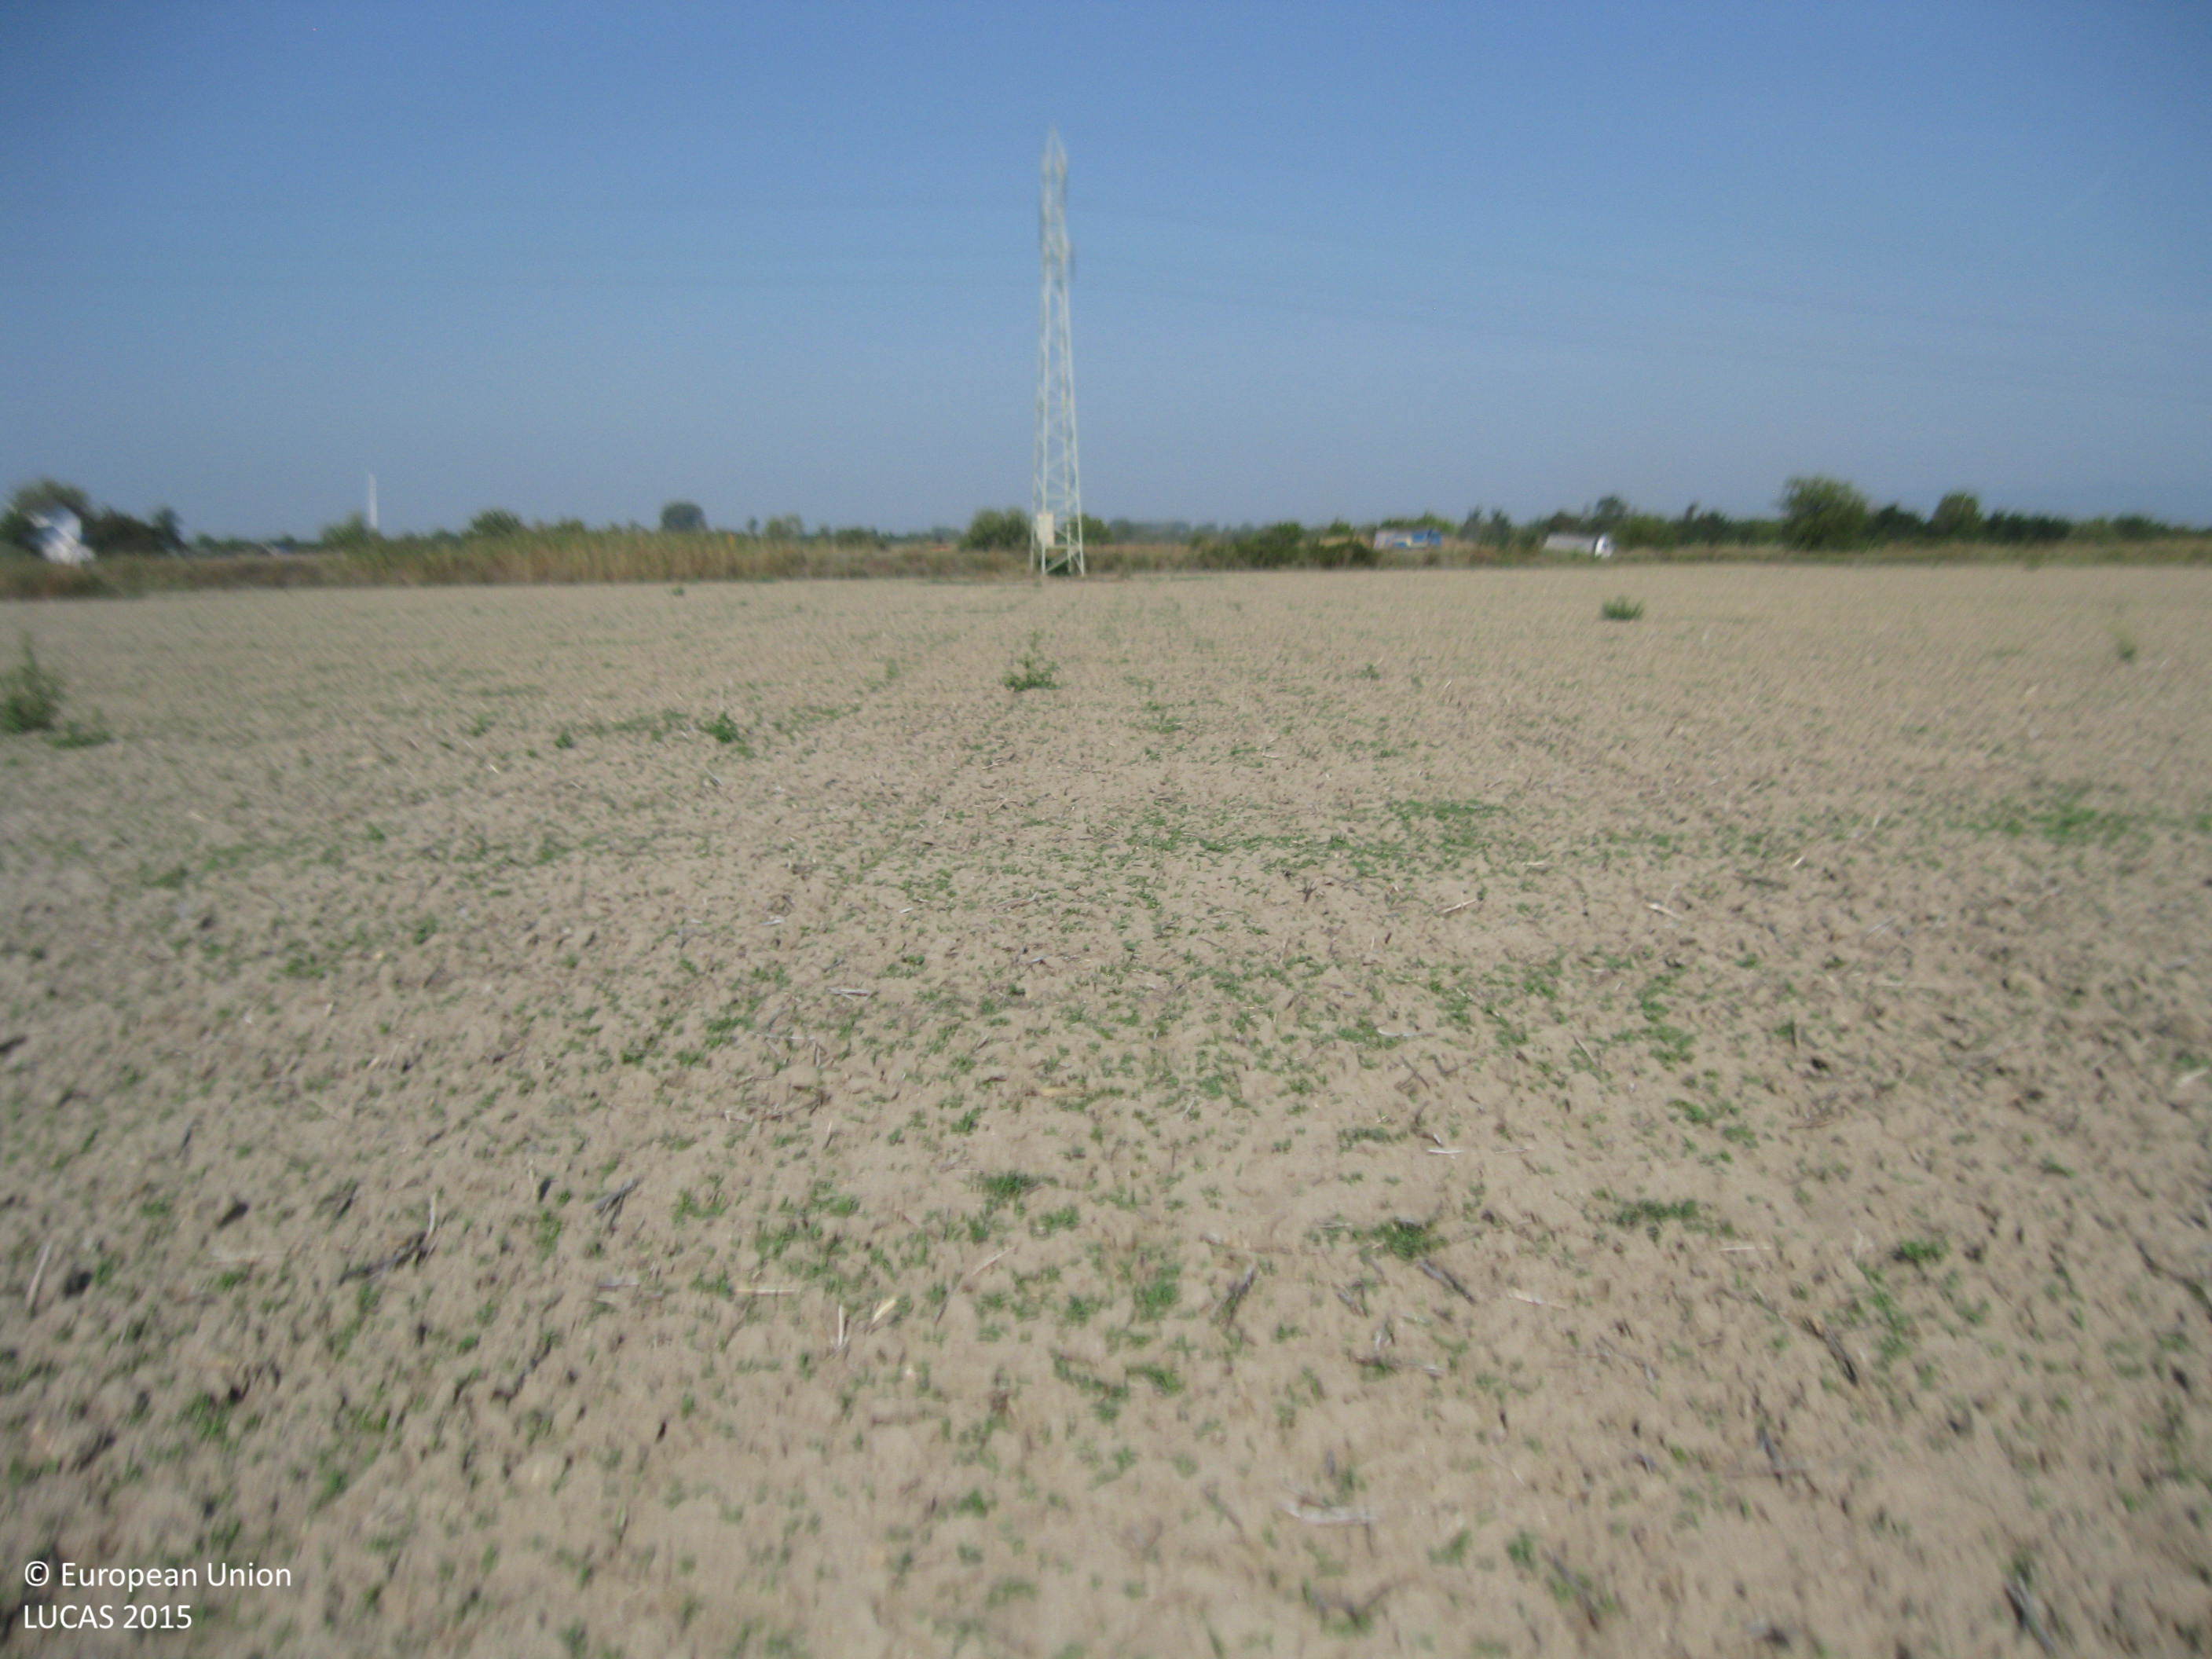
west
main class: Cropland
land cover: Sunflower
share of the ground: < 10 %
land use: Agriculture (excluding fallow land and kitchen gardens)
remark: Harvested field
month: September
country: BG
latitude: 42.2874
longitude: 24.8382
